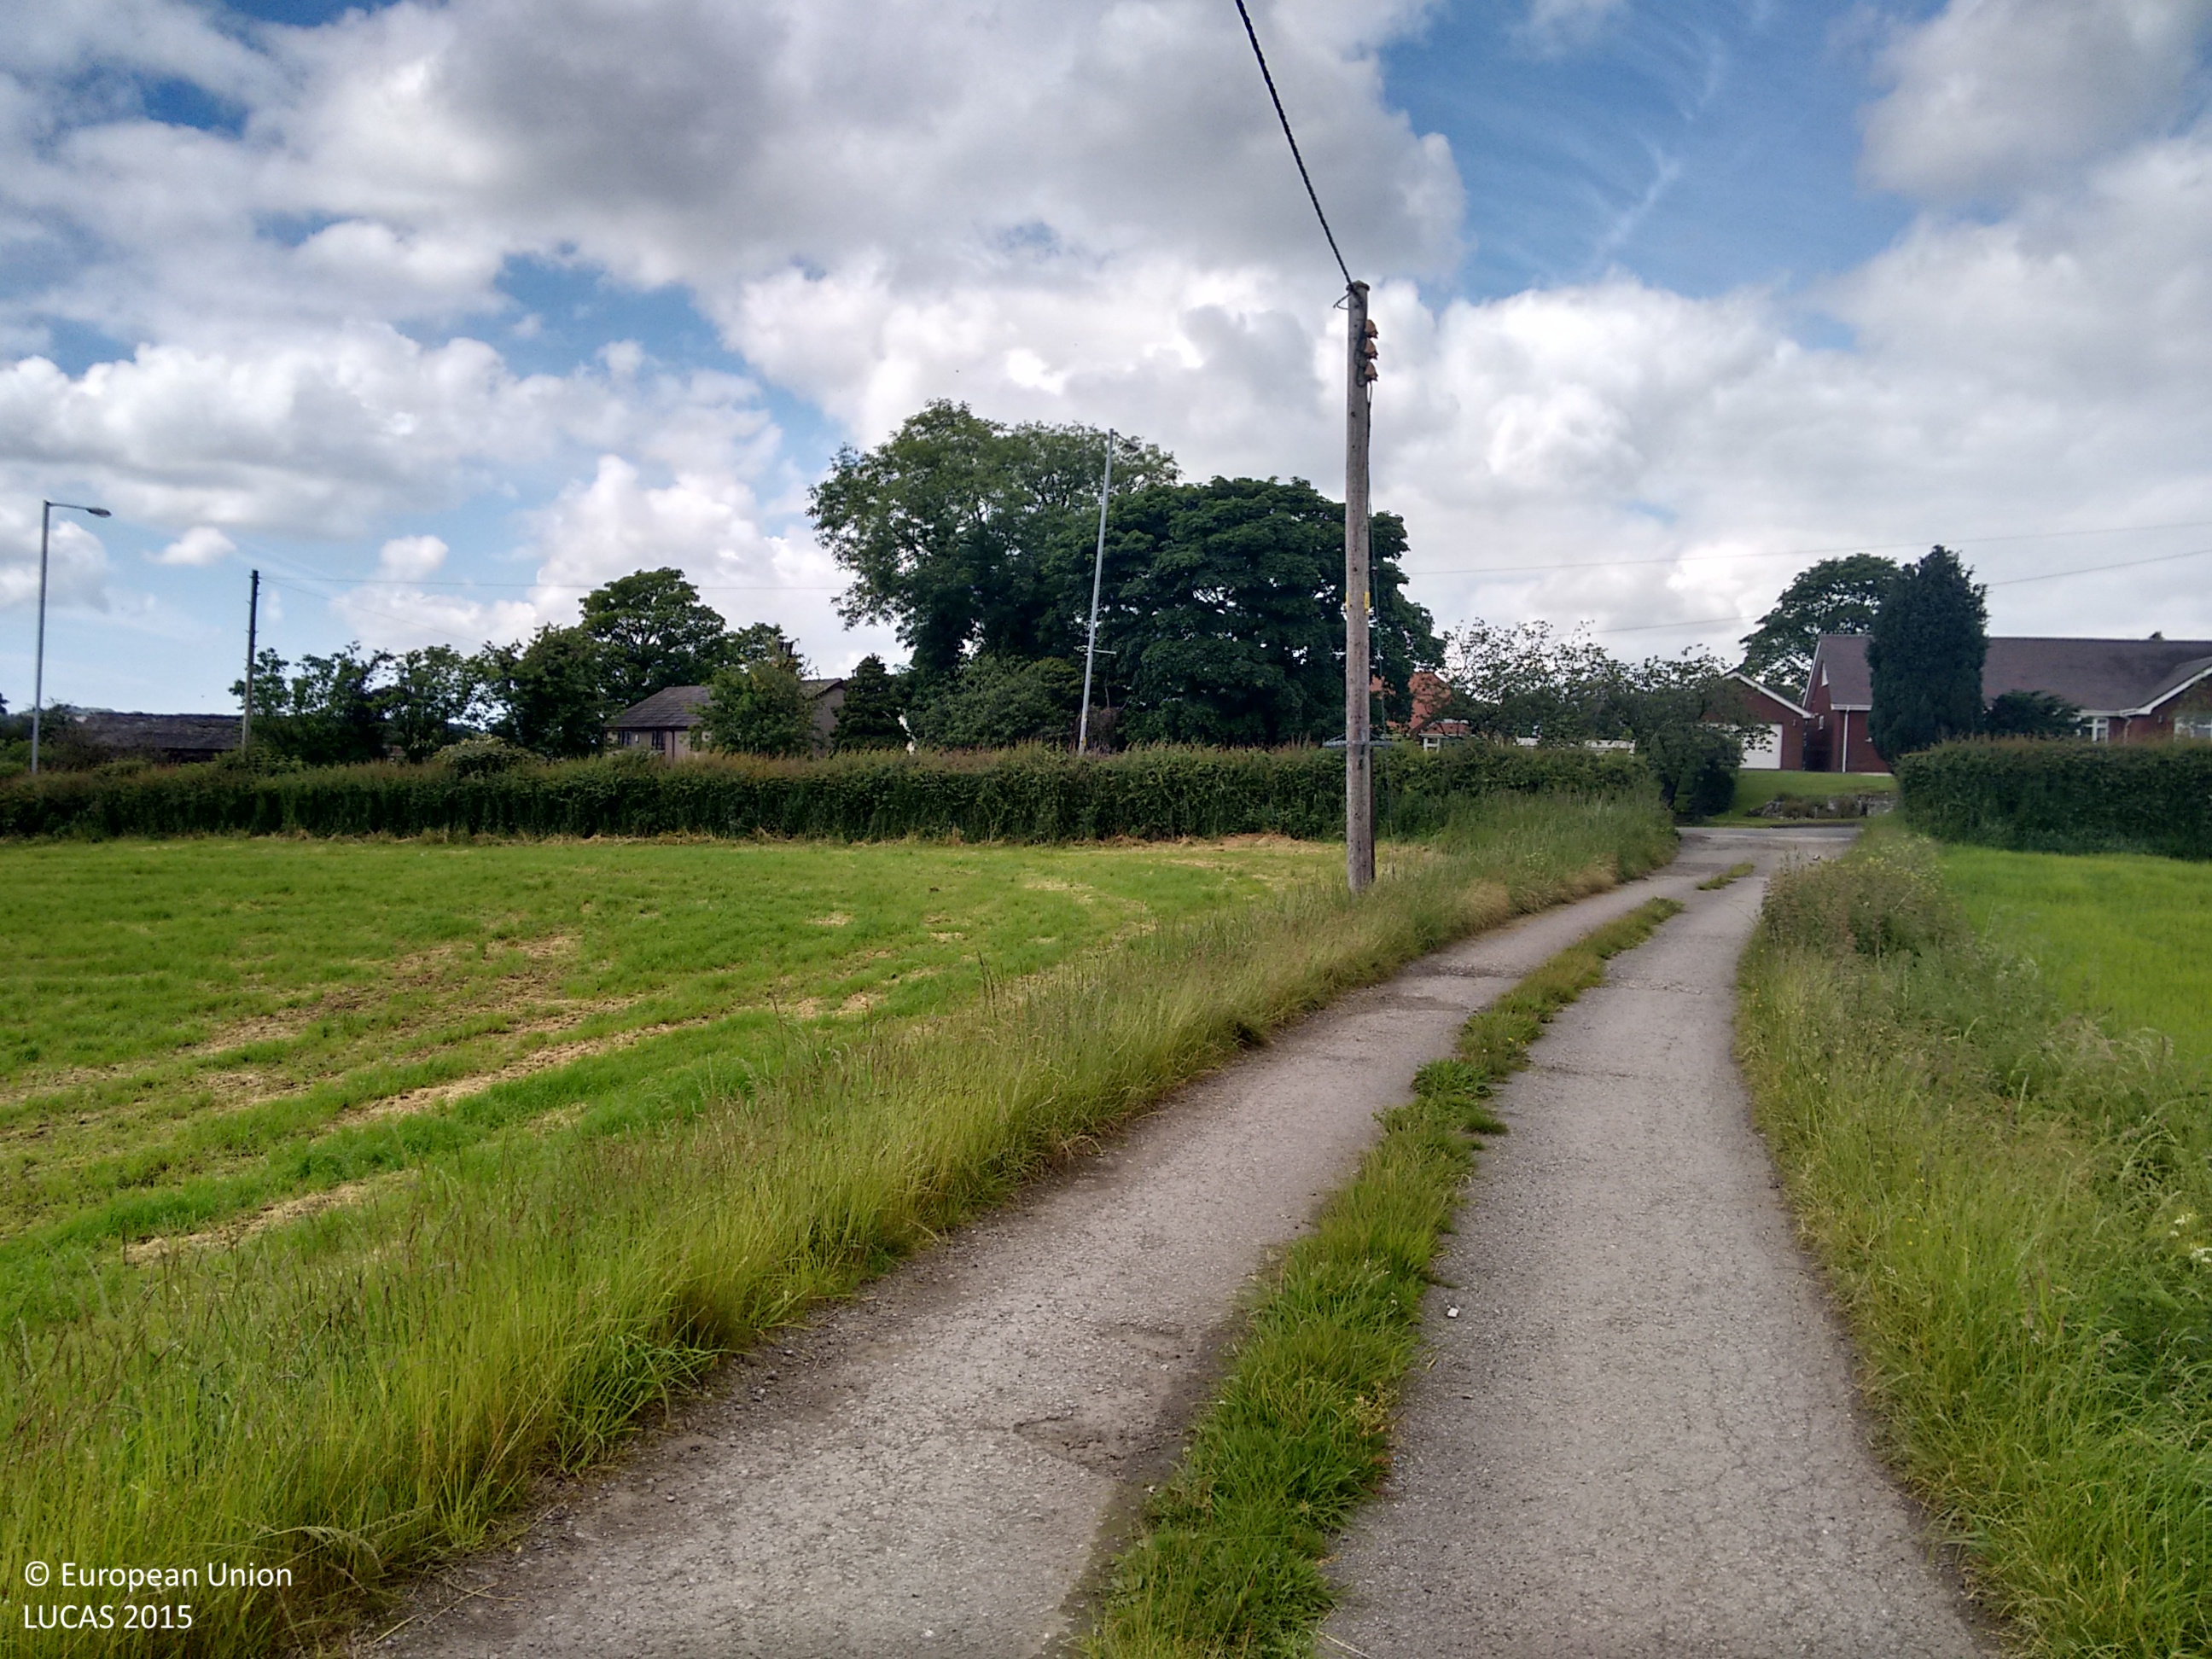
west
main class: Grassland
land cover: Grassland without tree/shrub cover
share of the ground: > 75 %
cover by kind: herbaceous plants 100 %
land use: Agriculture (excluding fallow land and kitchen gardens)
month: June
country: GB
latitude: 53.5648
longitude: -2.5527
